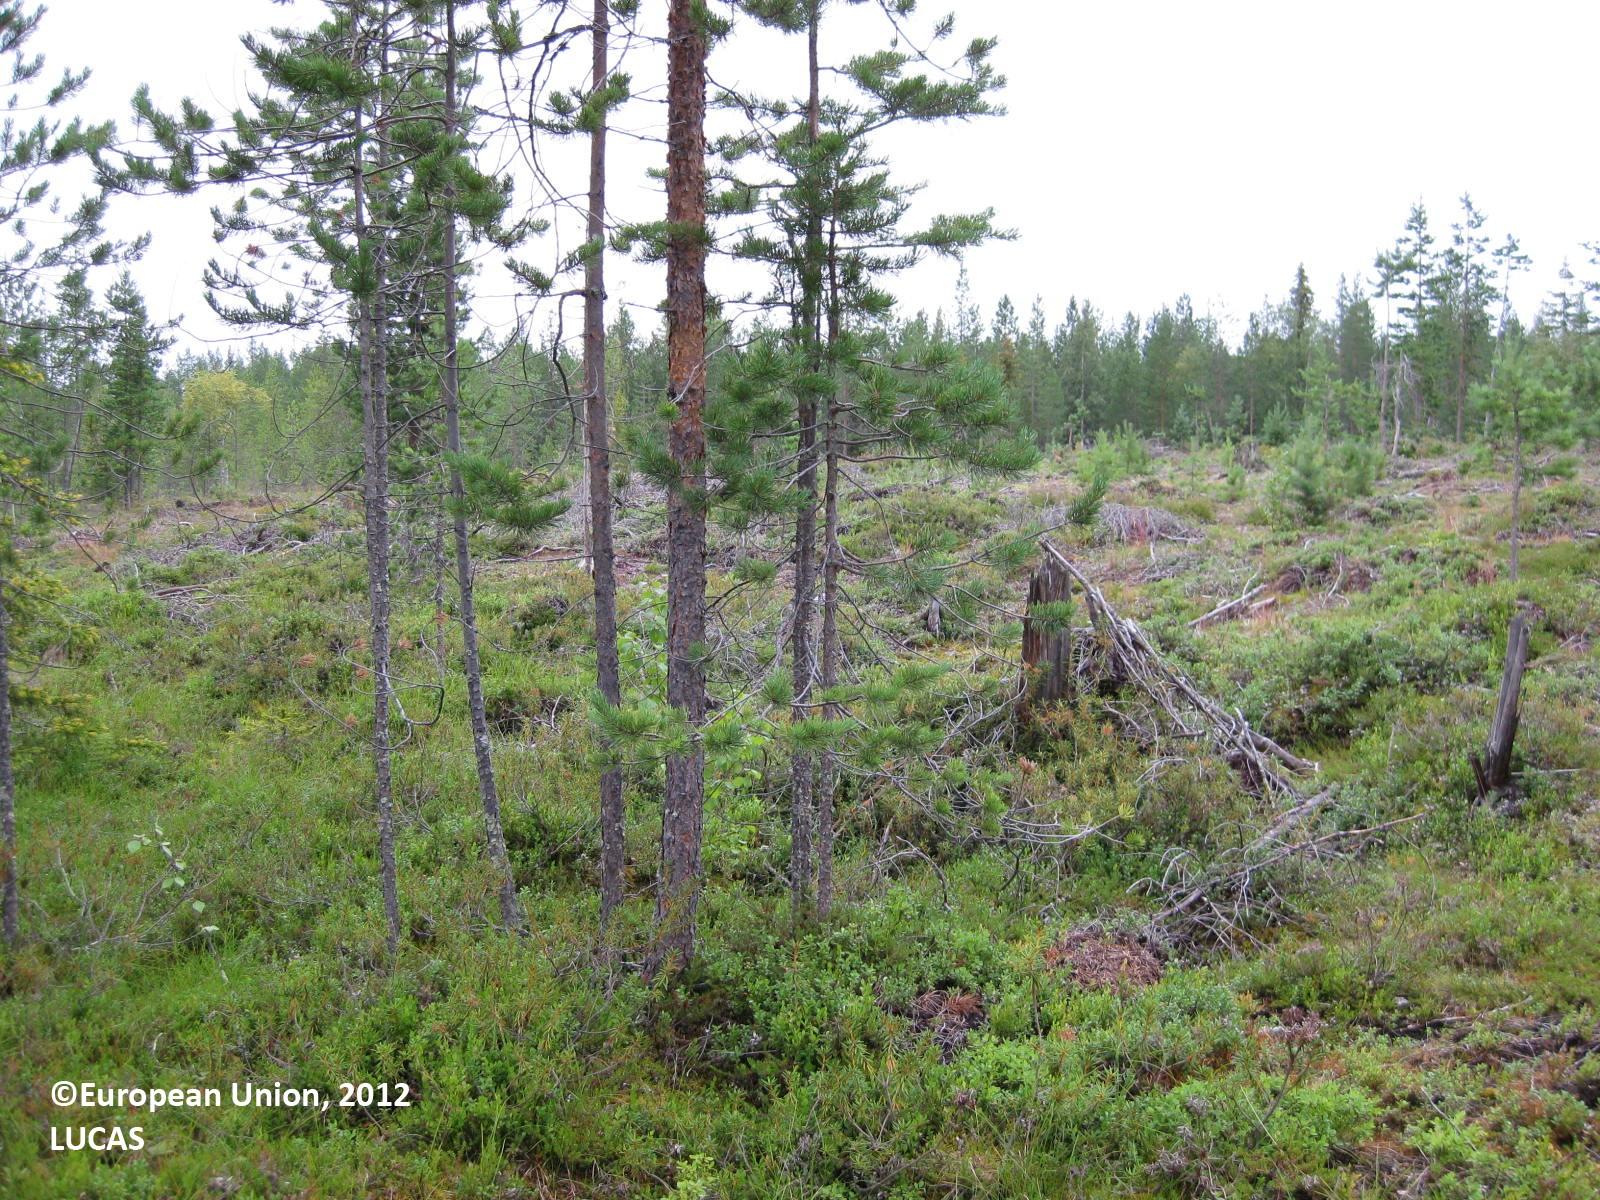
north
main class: Woodland
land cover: Pine dominated coniferous woodland
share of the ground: 50 - 75 %
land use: Forestry
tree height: > 5 m
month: August
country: FI
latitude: 65.8939
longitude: 28.1586
